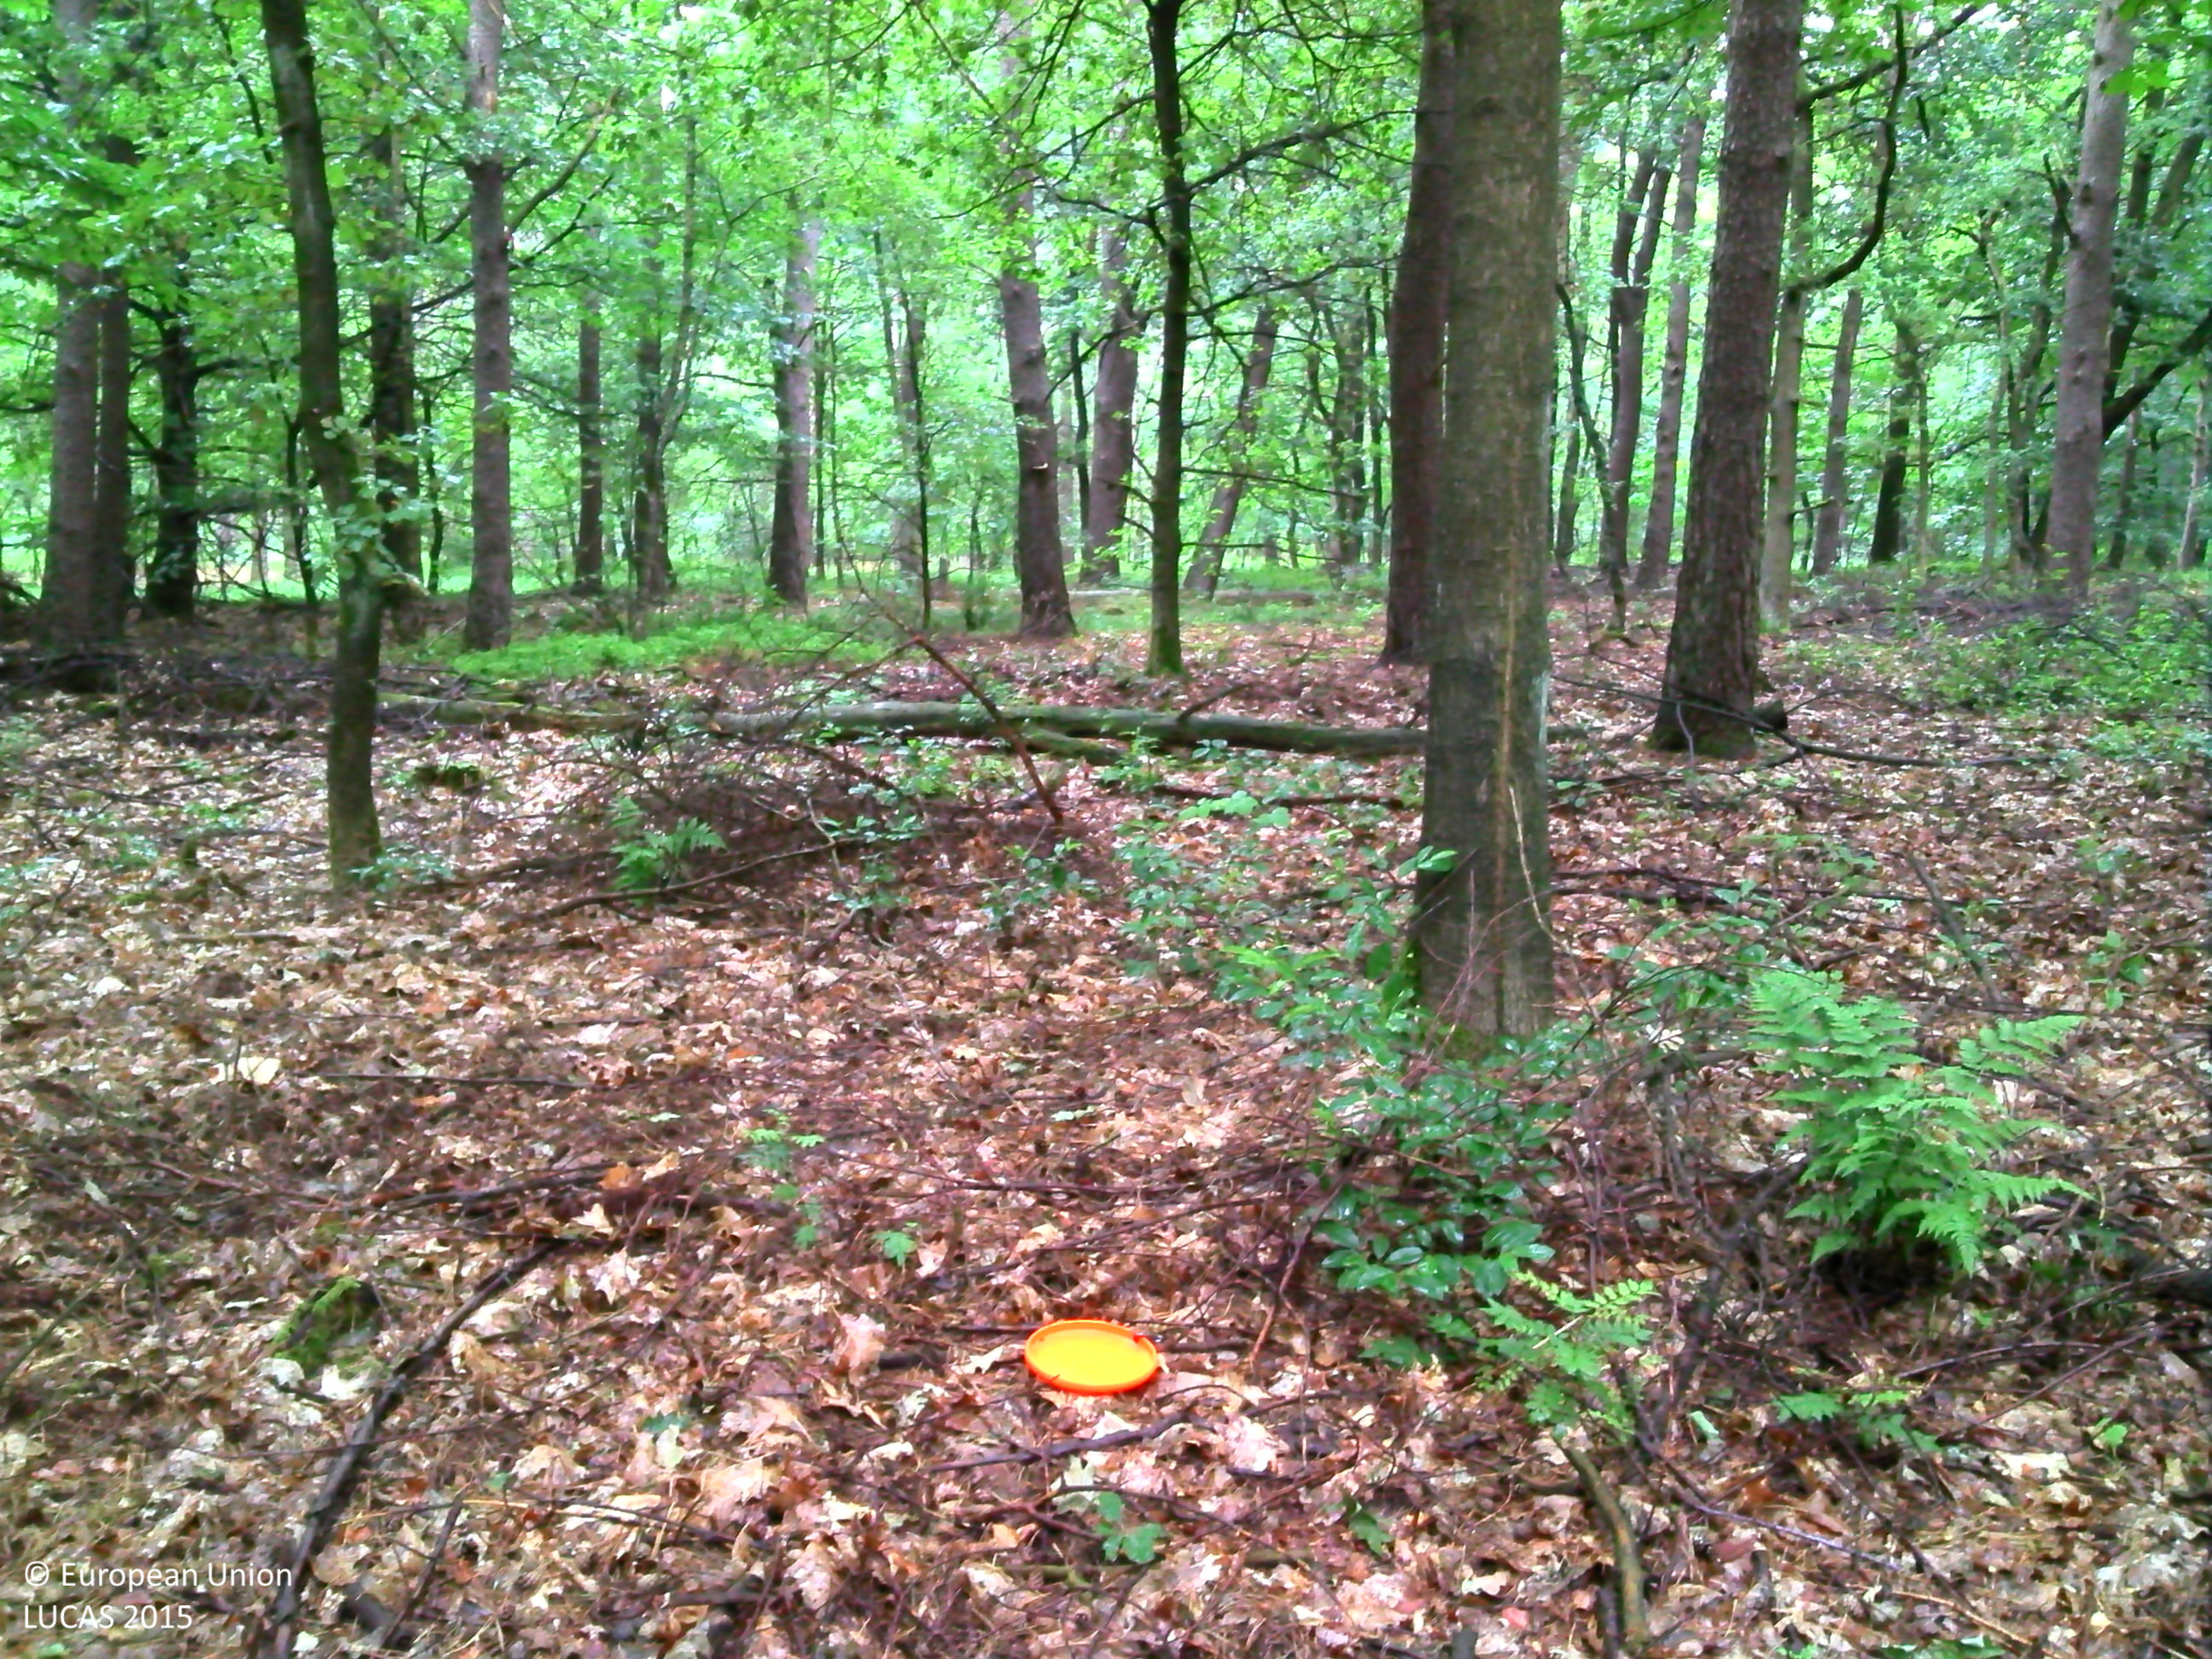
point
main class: Woodland
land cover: Pine dominated mixed woodland
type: mesophytic deciduous forest
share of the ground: > 75 %
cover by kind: coniferous forest trees 65 %, broadleaved forest trees 35 %
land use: Forestry
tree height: > 5 m
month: August
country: BE
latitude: 50.9805
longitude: 5.5685
